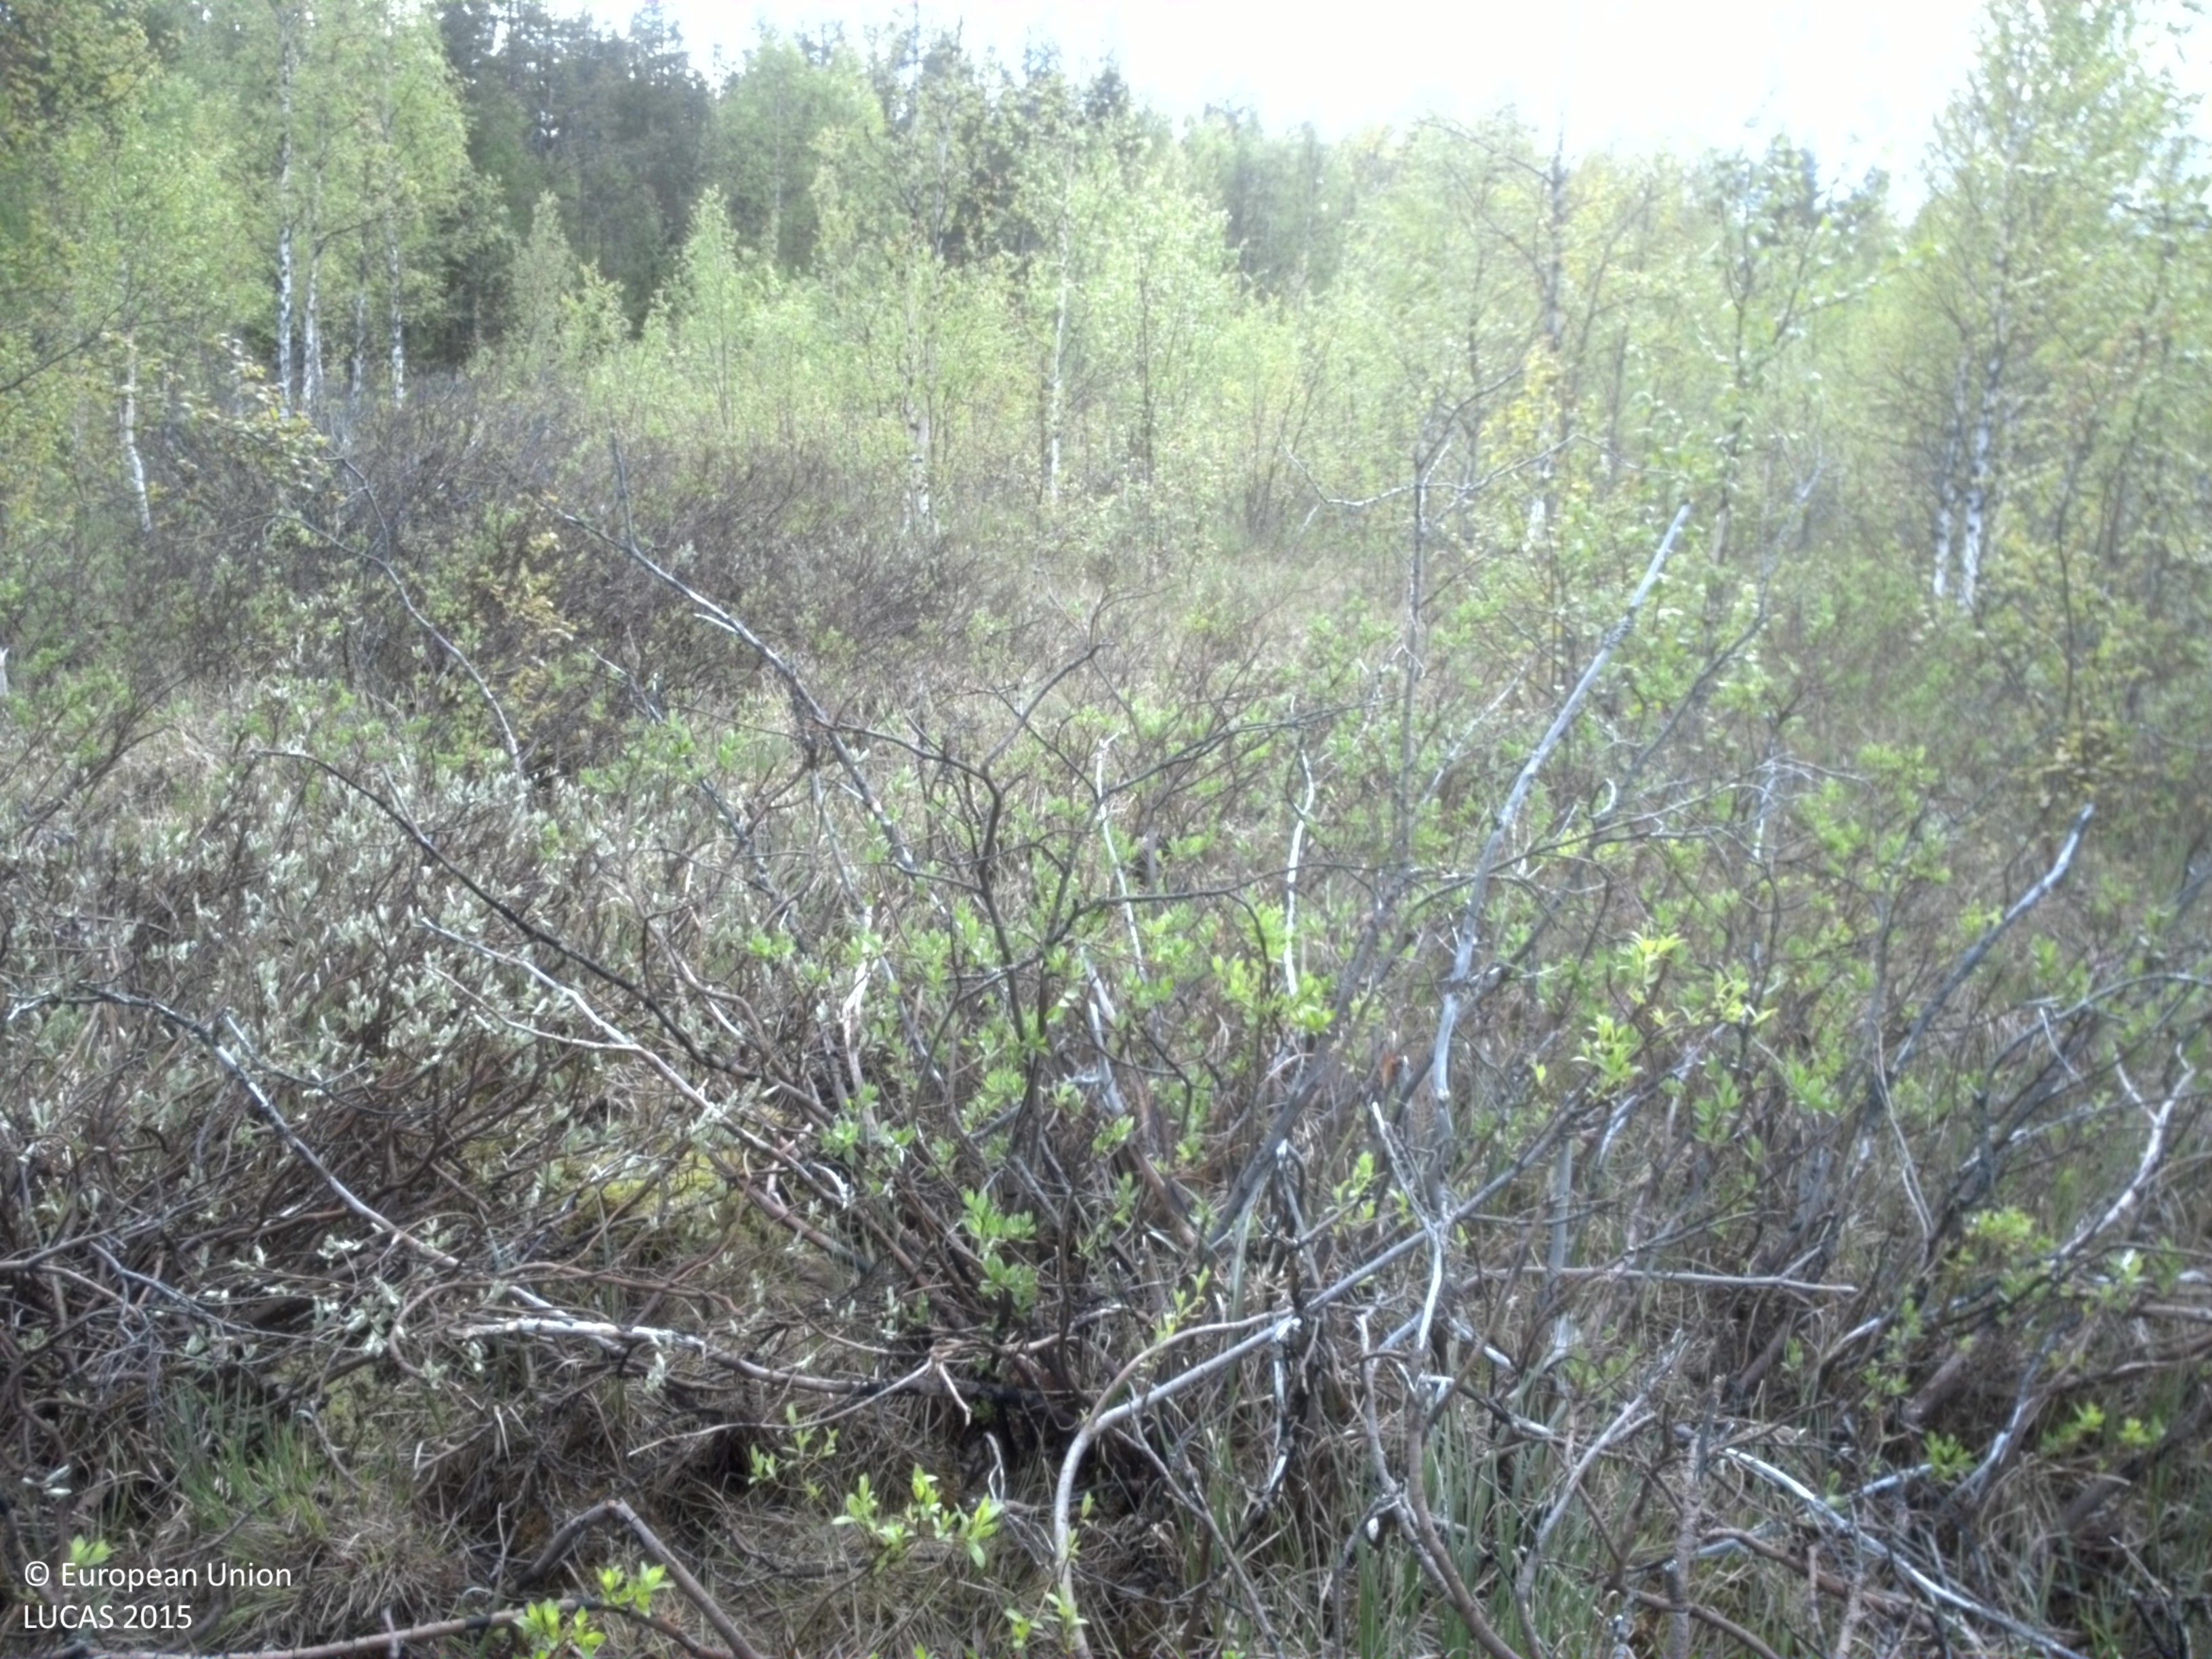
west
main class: Woodland
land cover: Broadleaved woodland
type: boreal forest
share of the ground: 25 - 50 %
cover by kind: shrubs 55 %, broadleaved forest trees 40 %, herbaceous plants 5 %
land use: Semi-natural and natural areas not in use
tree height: > 5 m
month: June
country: SE
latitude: 67.0127
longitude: 21.8681
